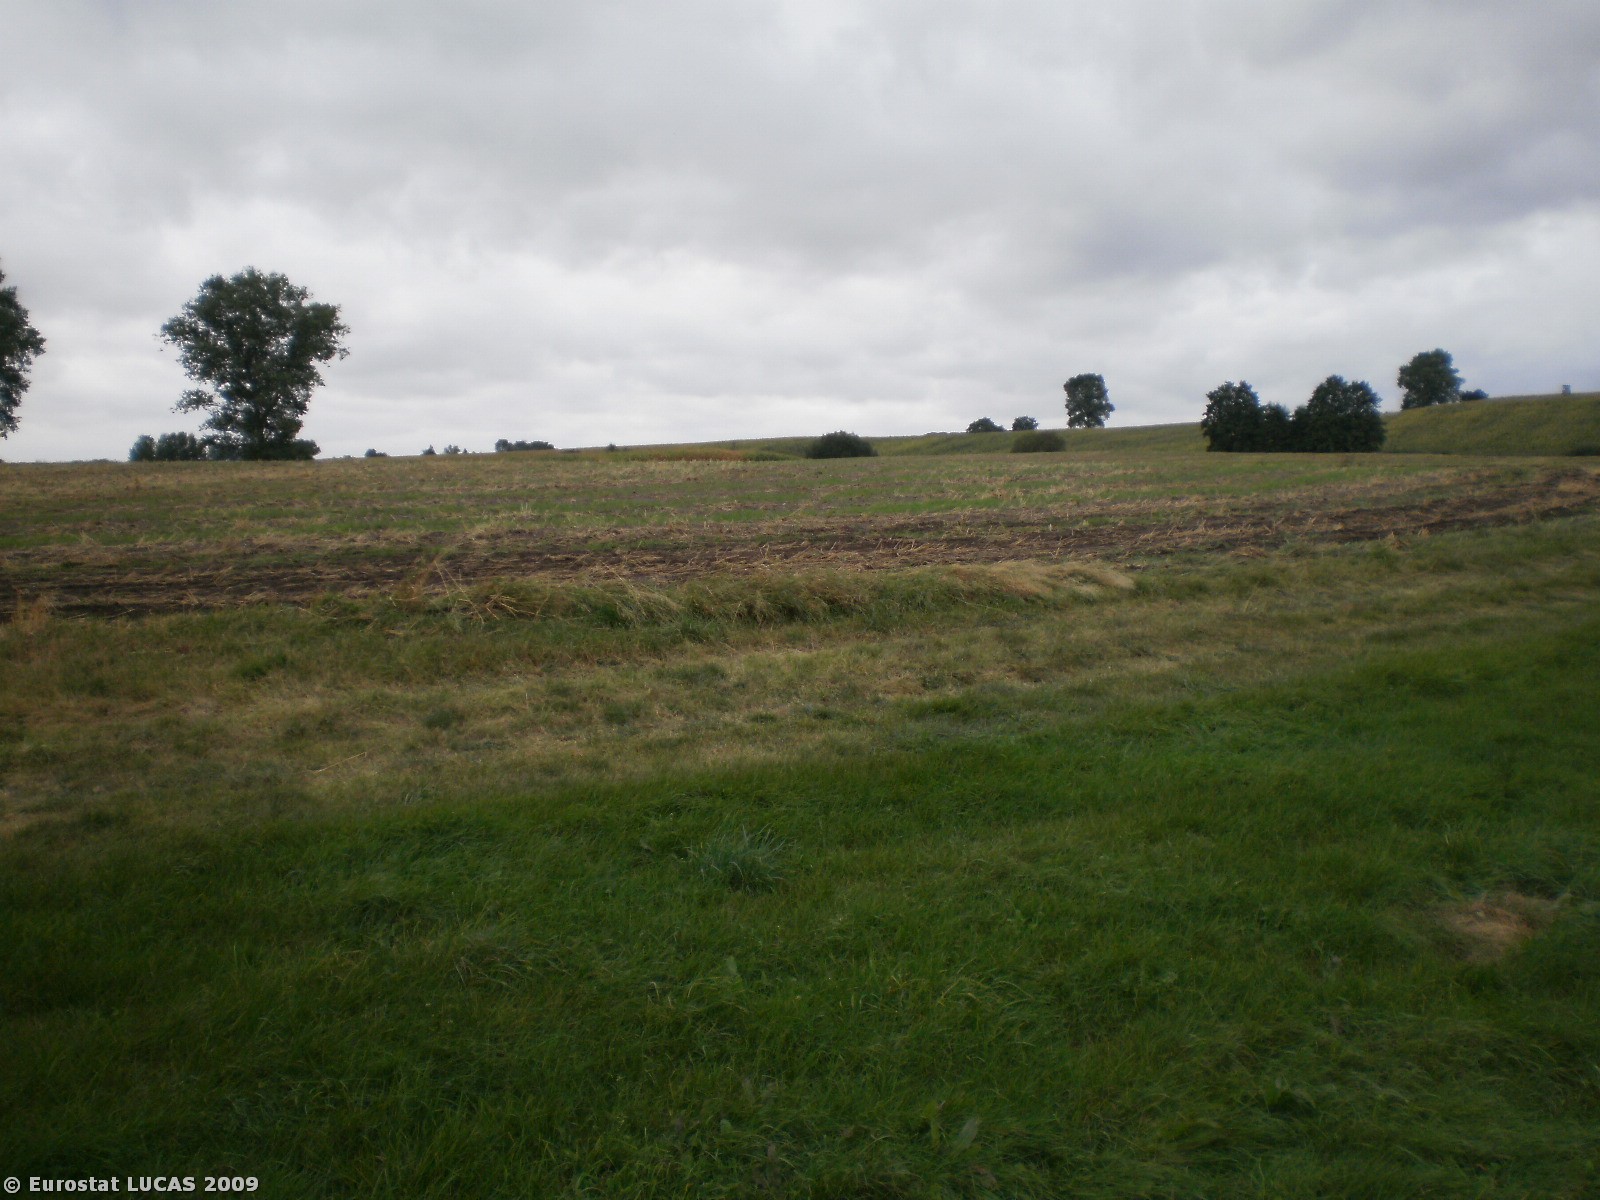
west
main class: Grassland
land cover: Grassland without tree/shrub cover
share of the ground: > 75 %
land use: Agriculture (excluding fallow land and kitchen gardens)
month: September
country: PL
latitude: 53.5899
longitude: 17.7025
